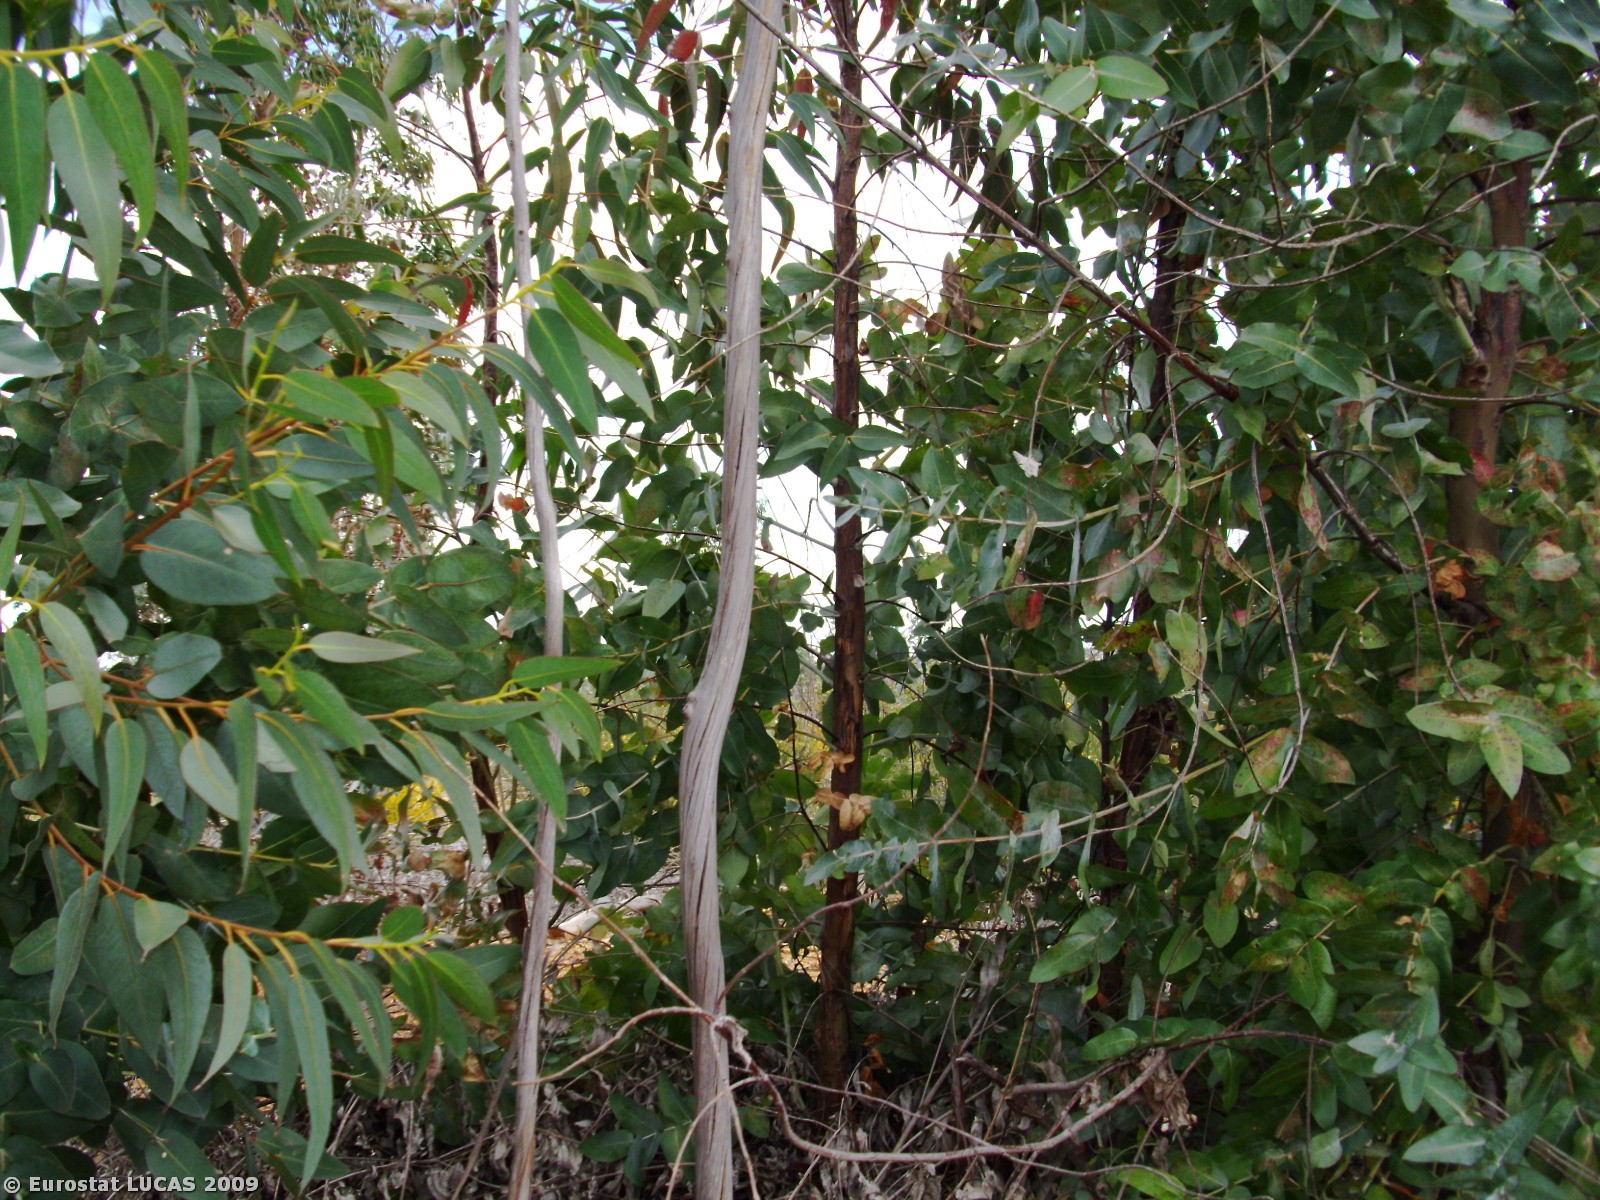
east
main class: Woodland
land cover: Broadleaved woodland
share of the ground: > 75 %
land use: Forestry
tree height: > 5 m
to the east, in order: Broadleaved woodland; Shrubland without tree cover; Tracks; Broadleaved woodland; Rivers and streams
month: April
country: PT
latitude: 39.7814
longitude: -7.4359
